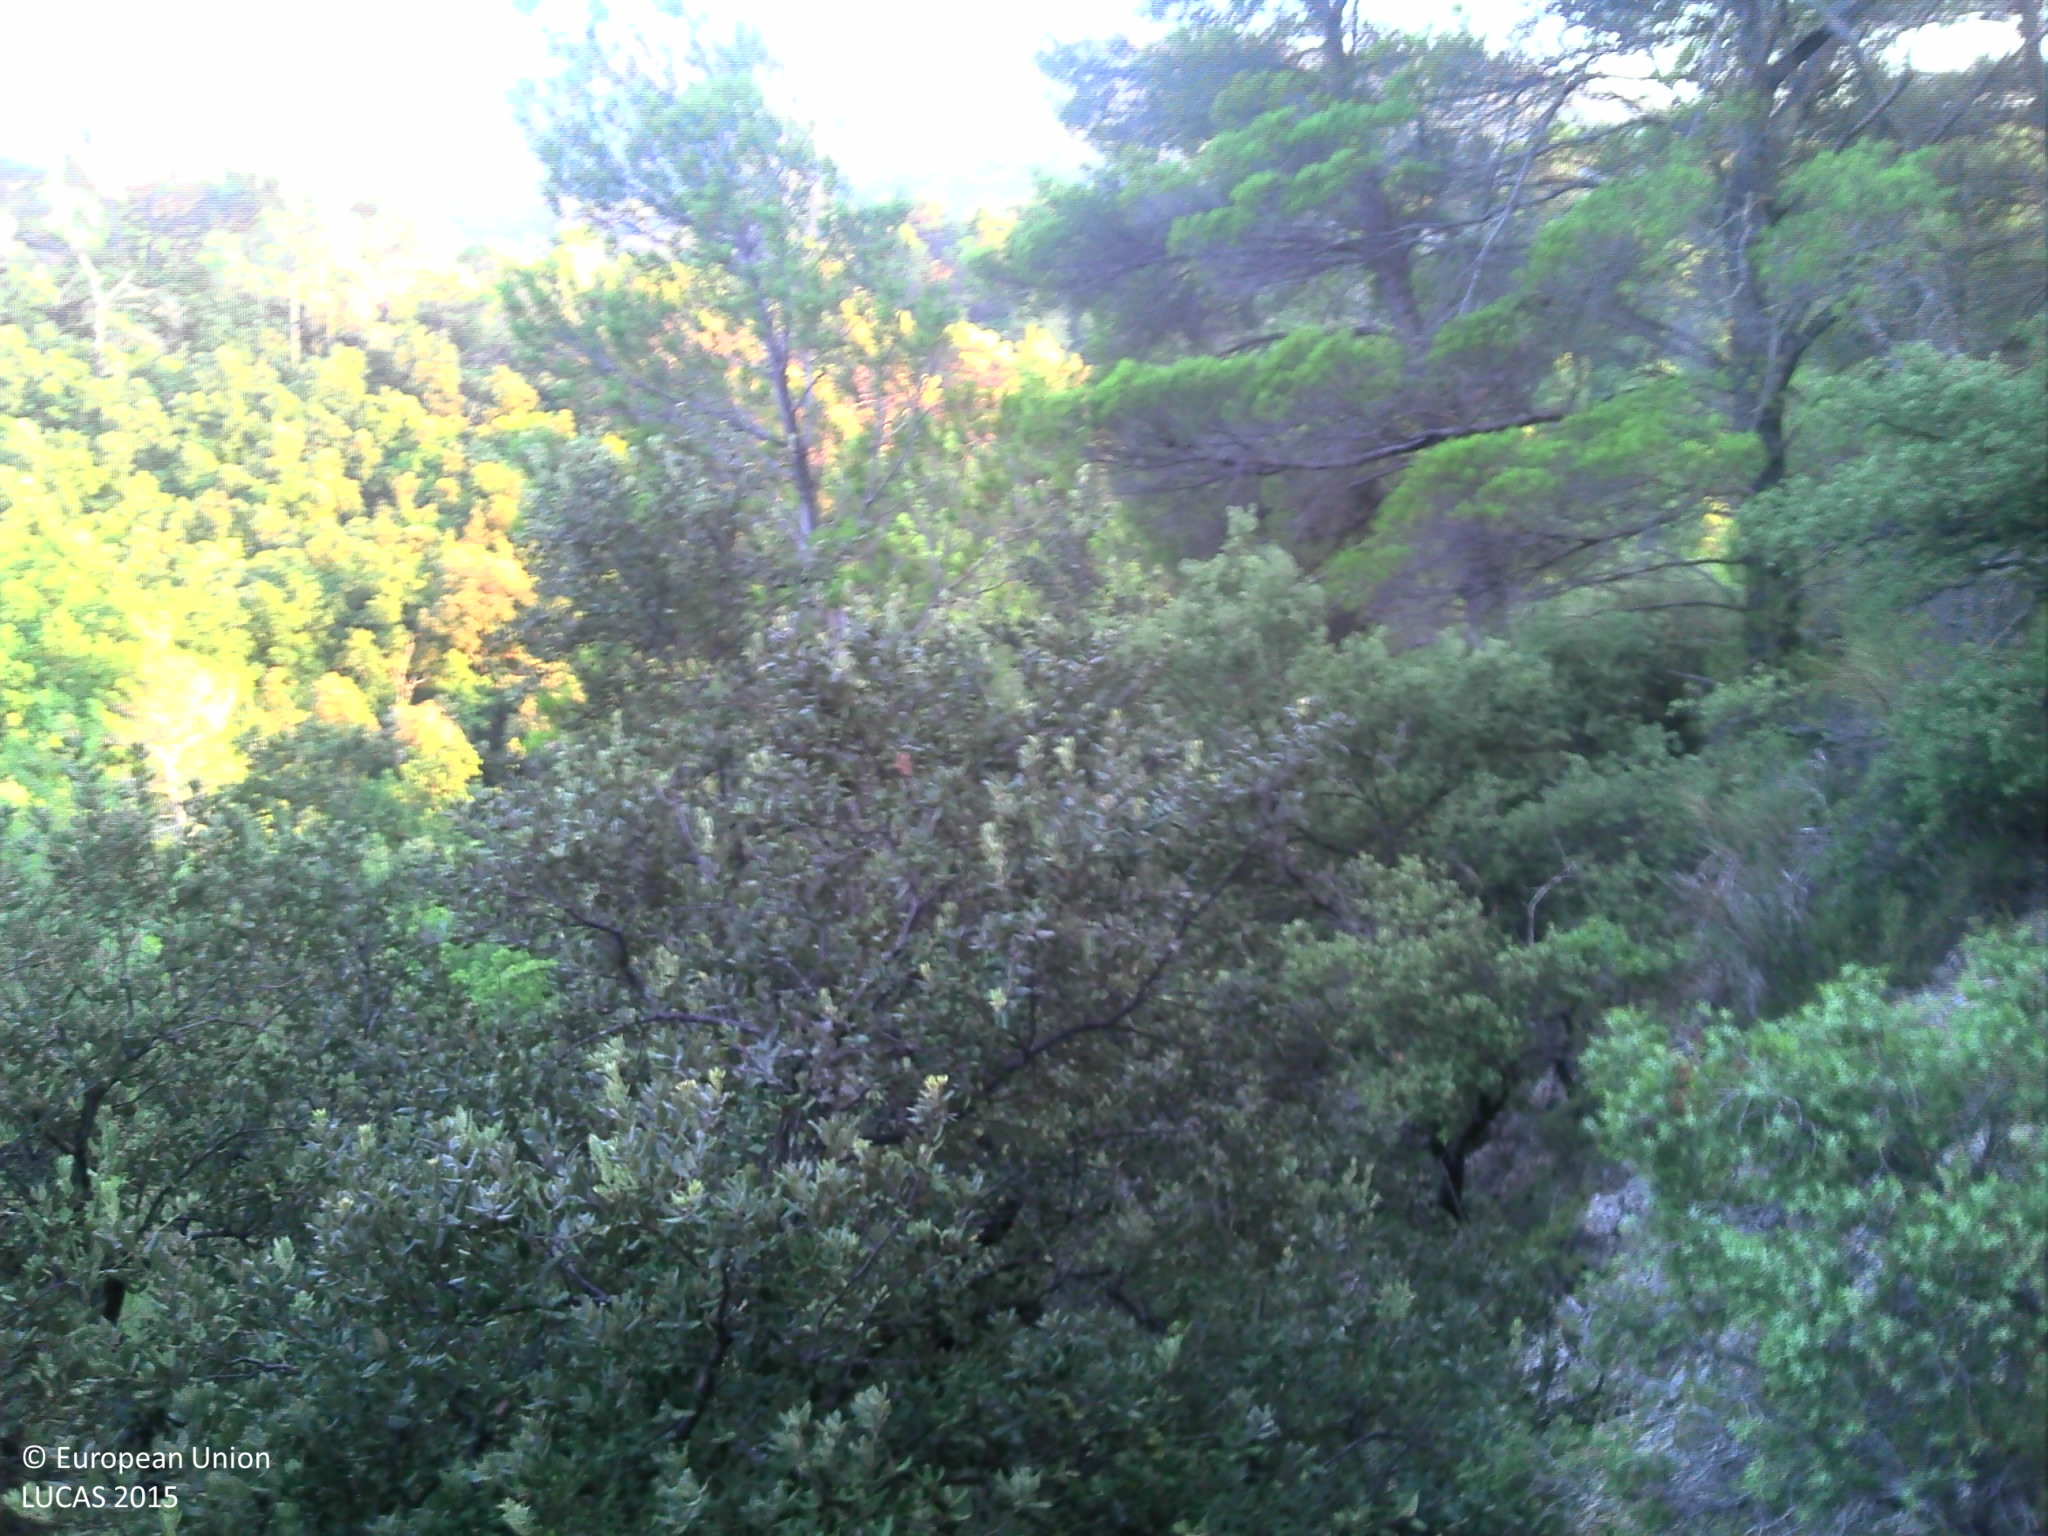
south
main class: Woodland
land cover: Pine dominated mixed woodland
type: thermophilous deciduous forest
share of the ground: > 75 %
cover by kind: coniferous forest trees 30 %, broadleaved forest trees 30 %, unconsolidated bare surface 20 %, shrubs 10 %, herbaceous plants 10 %
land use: Semi-natural and natural areas not in use
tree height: > 5 m
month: August
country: FR
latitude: 43.5523
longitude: 5.5905
